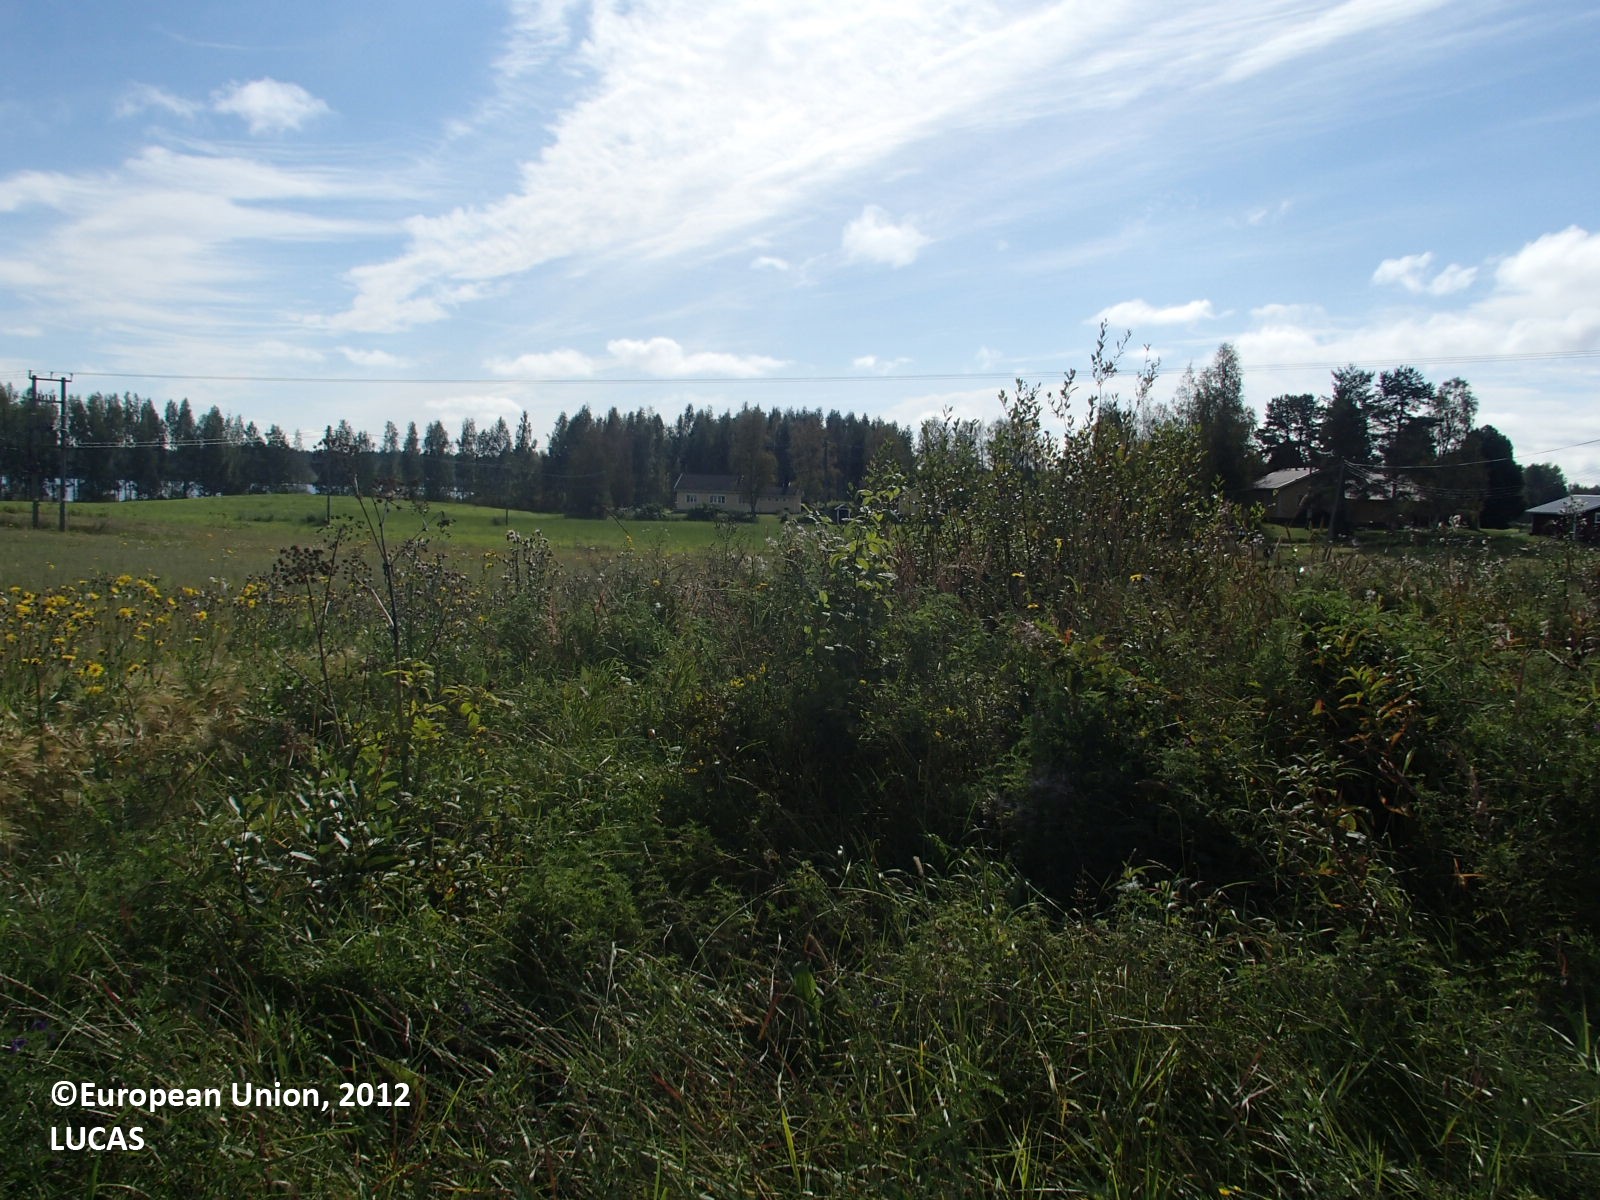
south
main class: Cropland
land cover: Oats
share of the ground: > 75 %
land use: Agriculture (excluding fallow land and kitchen gardens)
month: August
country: FI
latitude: 63.6031
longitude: 27.1389
